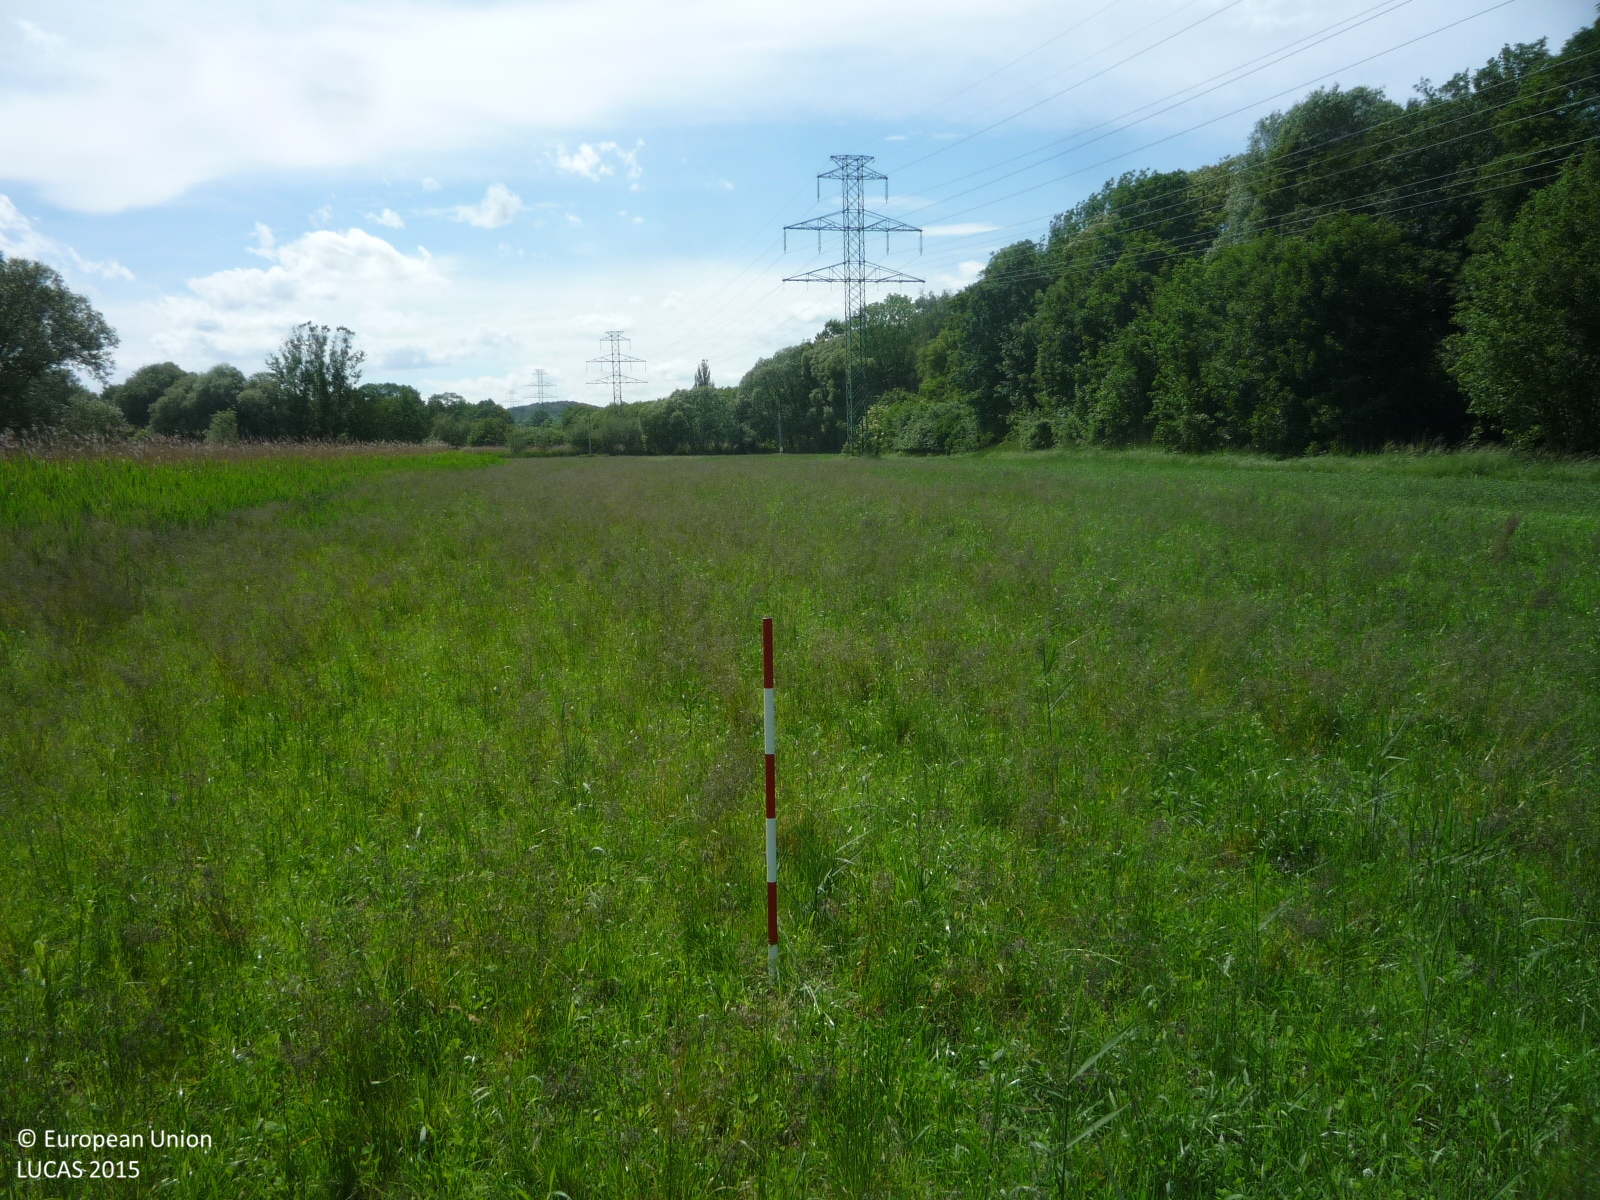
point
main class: Cropland
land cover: Temporary grasslands
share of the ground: > 75 %
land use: Agriculture (excluding fallow land and kitchen gardens)
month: June
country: CZ
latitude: 50.2004
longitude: 14.1059
